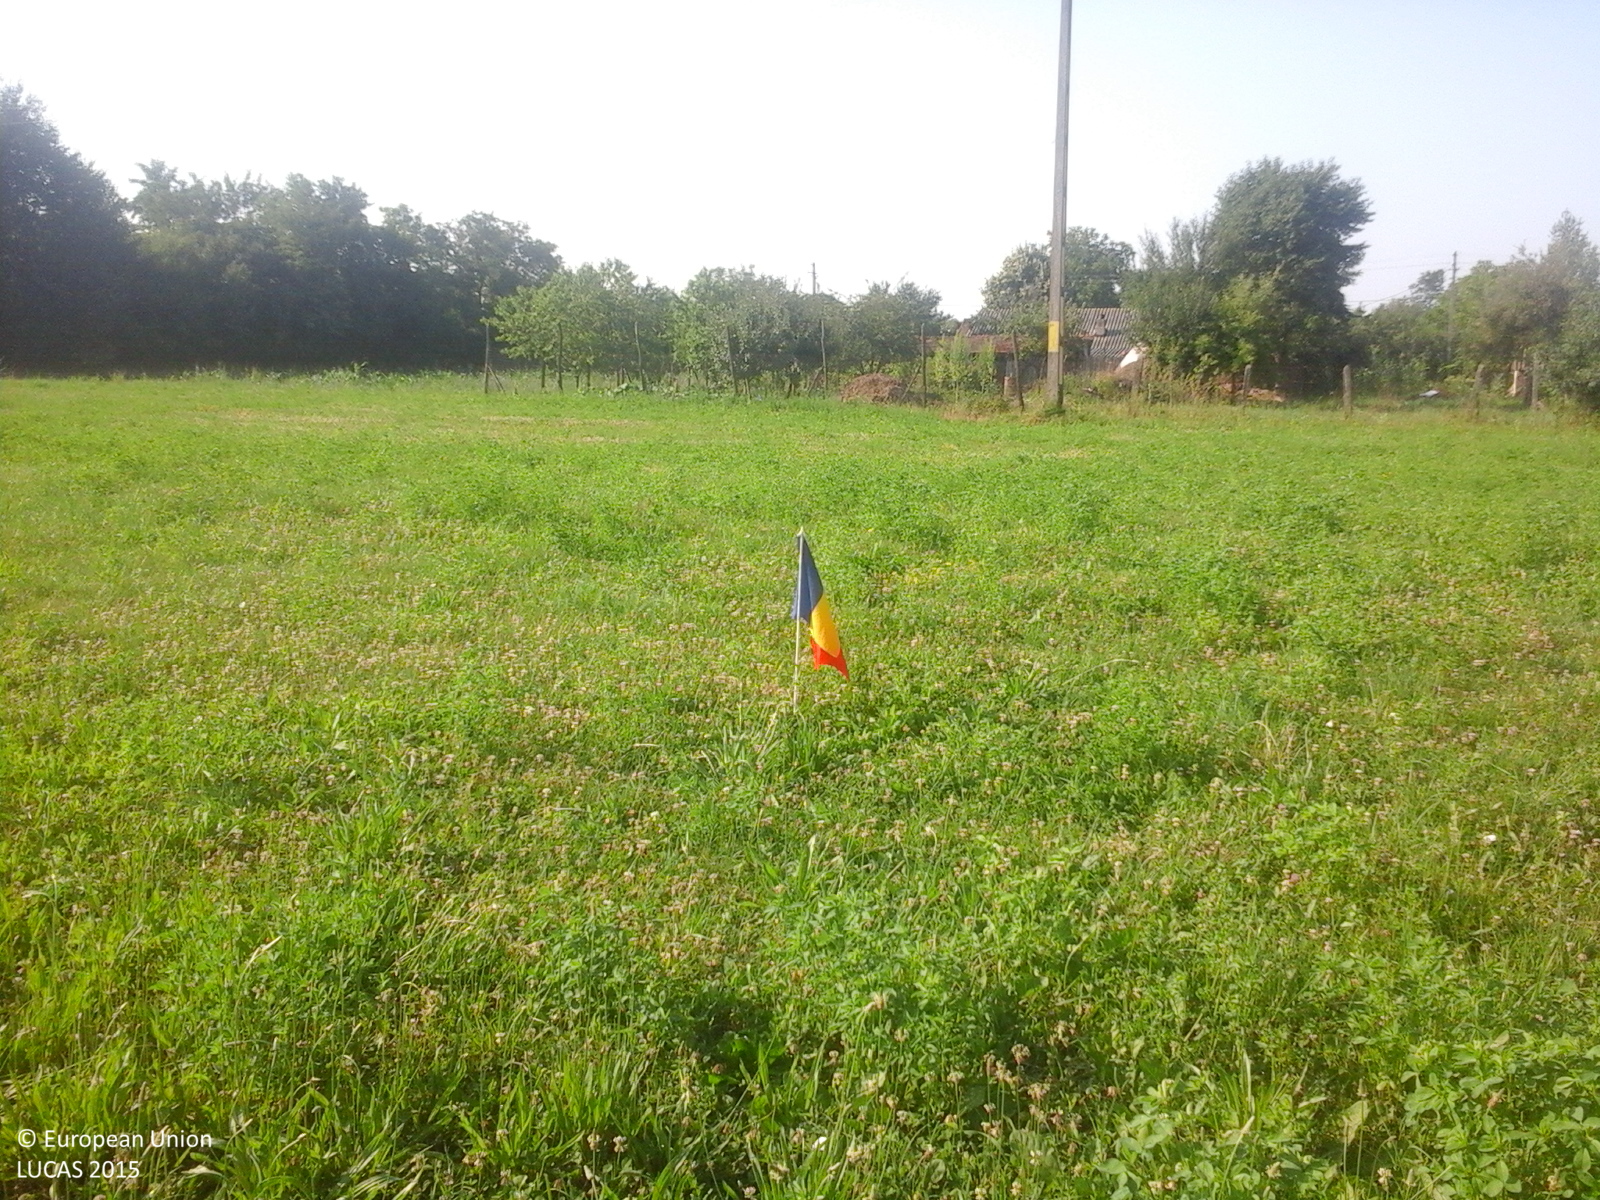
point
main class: Cropland
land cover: Other leguminous and mixtures for fodder
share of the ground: > 75 %
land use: Agriculture (excluding fallow land and kitchen gardens)
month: July
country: RO
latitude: 44.5118
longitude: 24.7822
